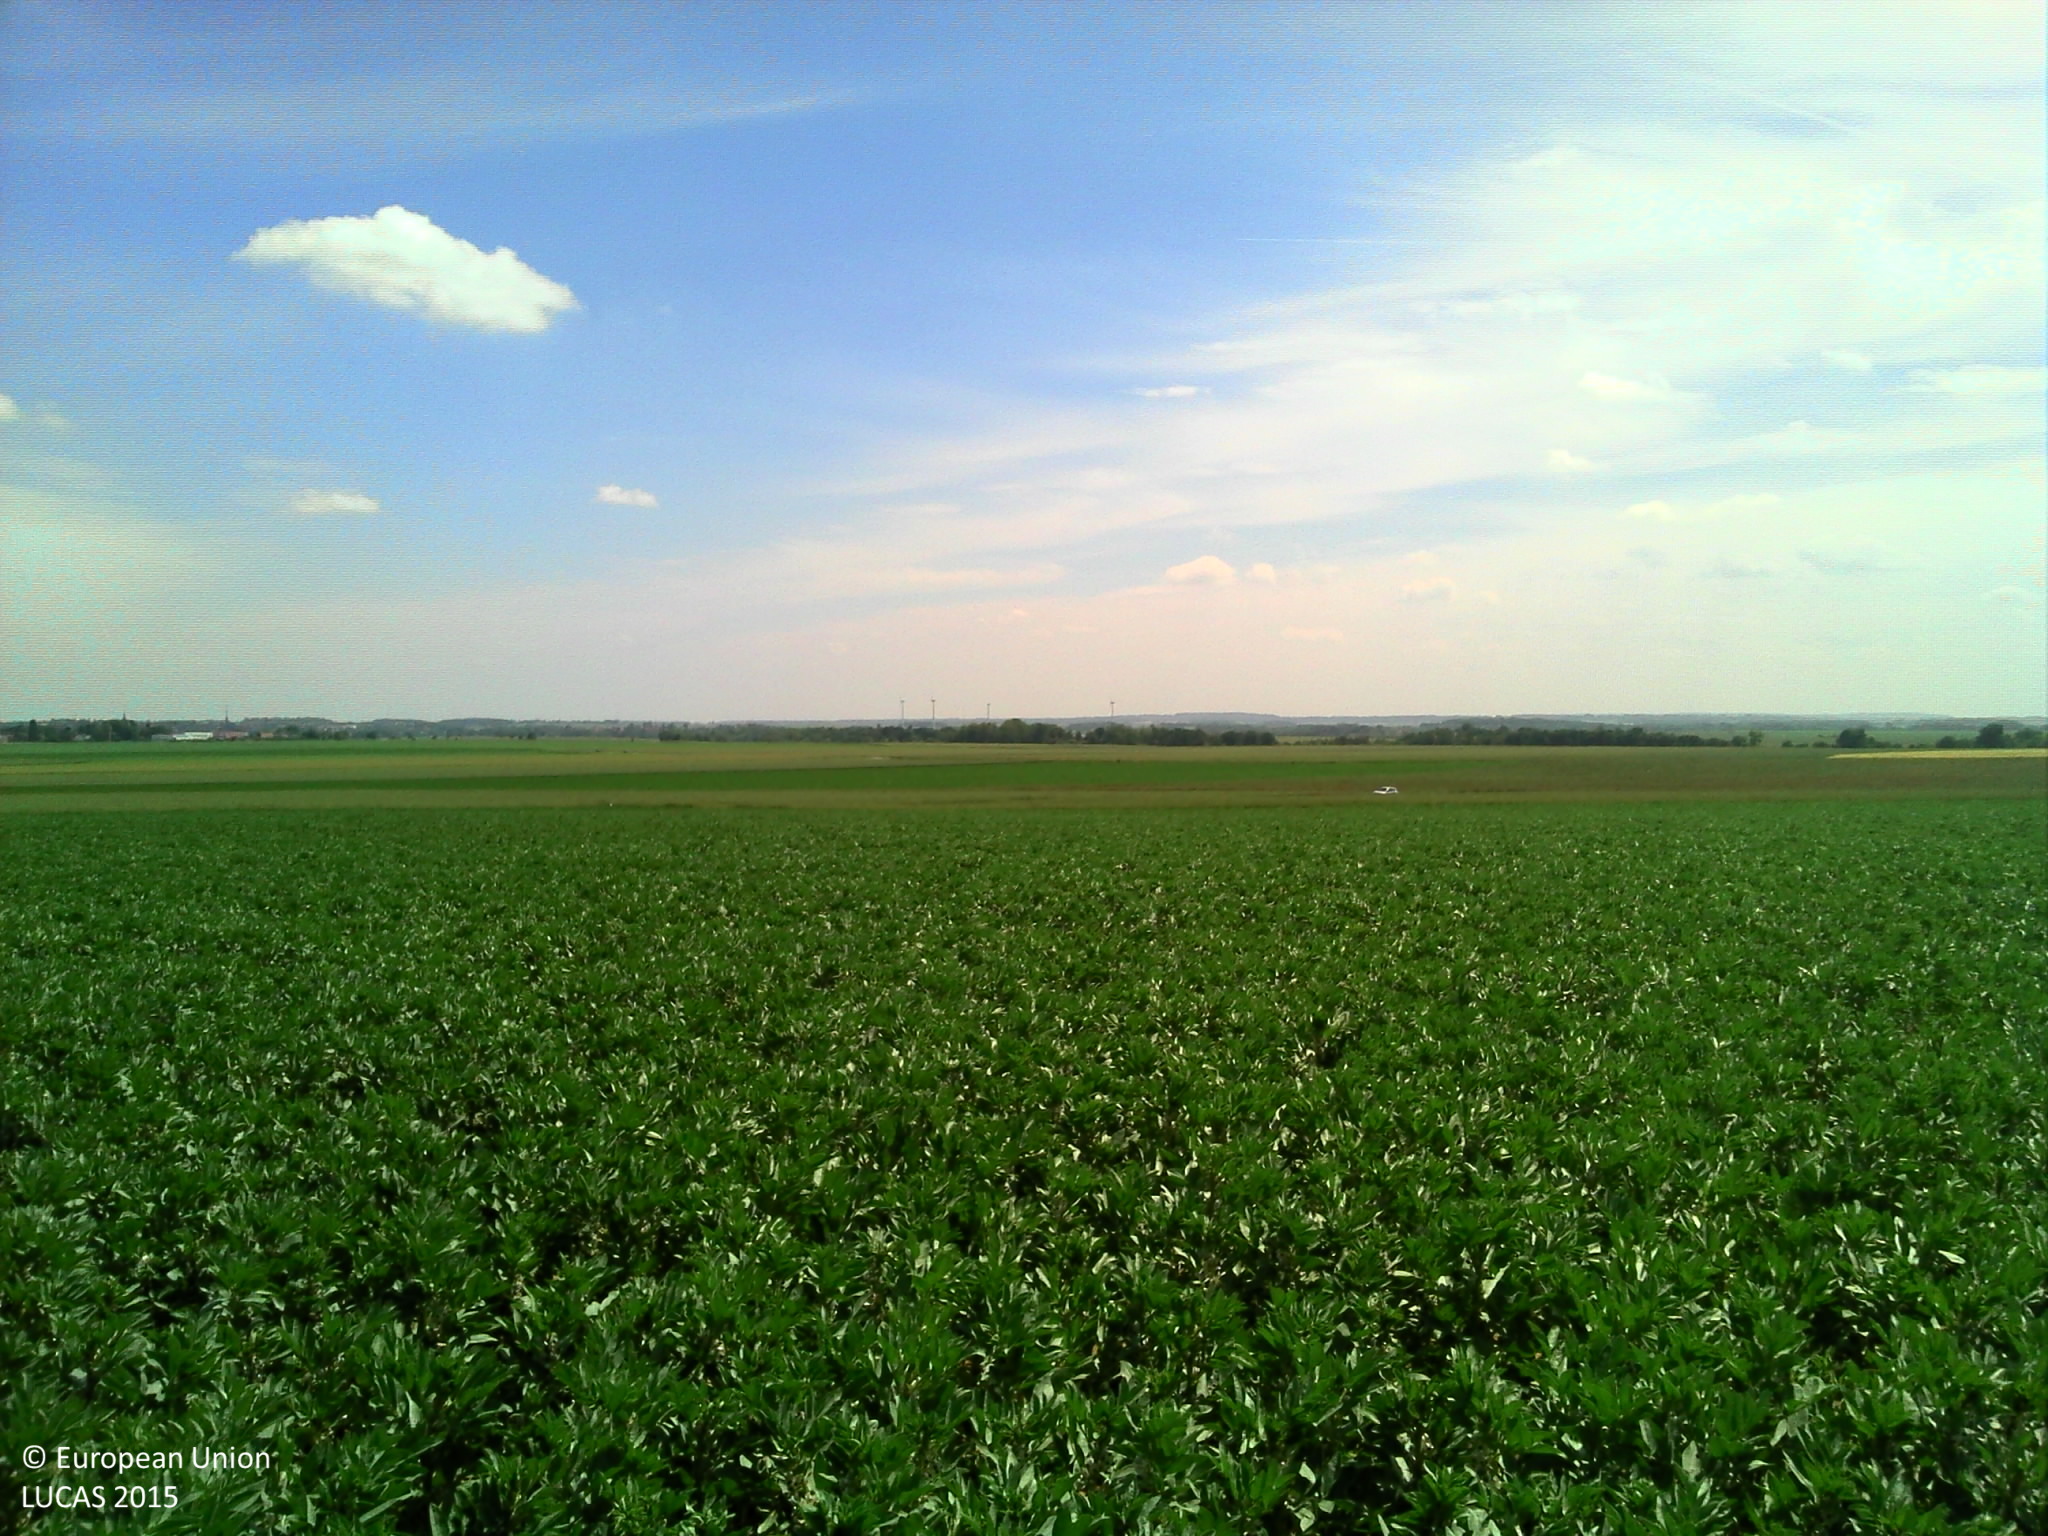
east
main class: Cropland
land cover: Dry pulses
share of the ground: > 75 %
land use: Agriculture (excluding fallow land and kitchen gardens)
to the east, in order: Dry pulses; Common wheat; Grass margins; Tracks; Grass margins; Common wheat
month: June
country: FR
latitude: 49.6299
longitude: 2.4978
